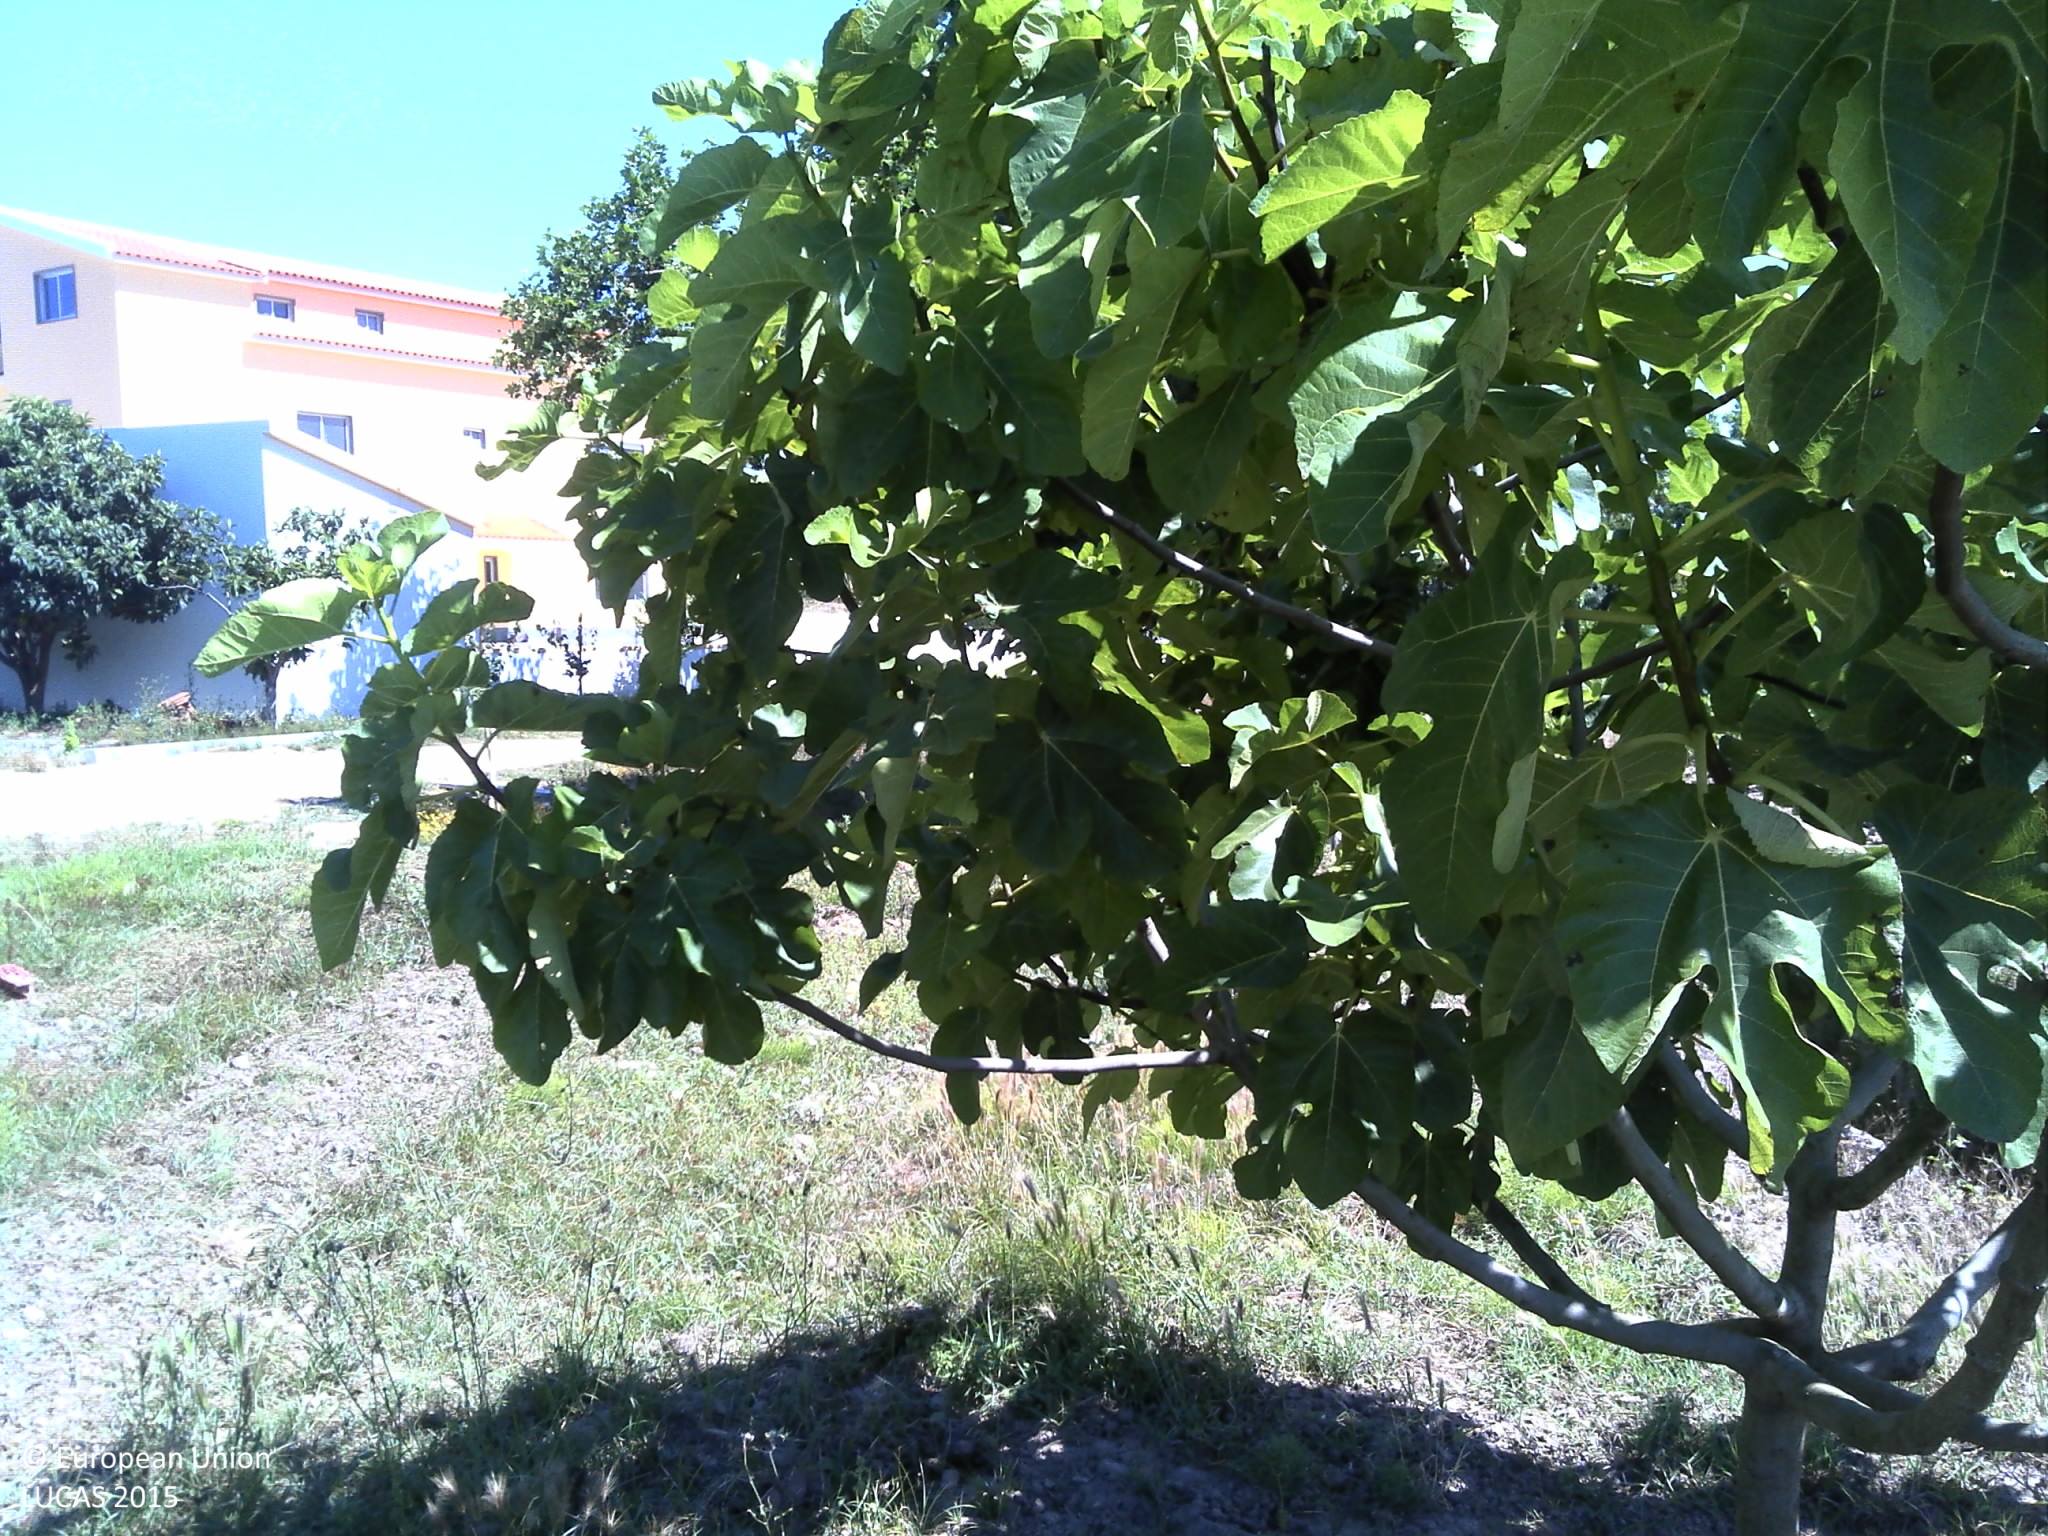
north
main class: Cropland
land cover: Other fruit trees and berries
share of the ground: 25 - 50 %
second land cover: Grassland without tree/shrub cover
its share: 50 - 75 %
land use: Kitchen garden
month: June
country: PT
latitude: 39.1408
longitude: -9.2343
